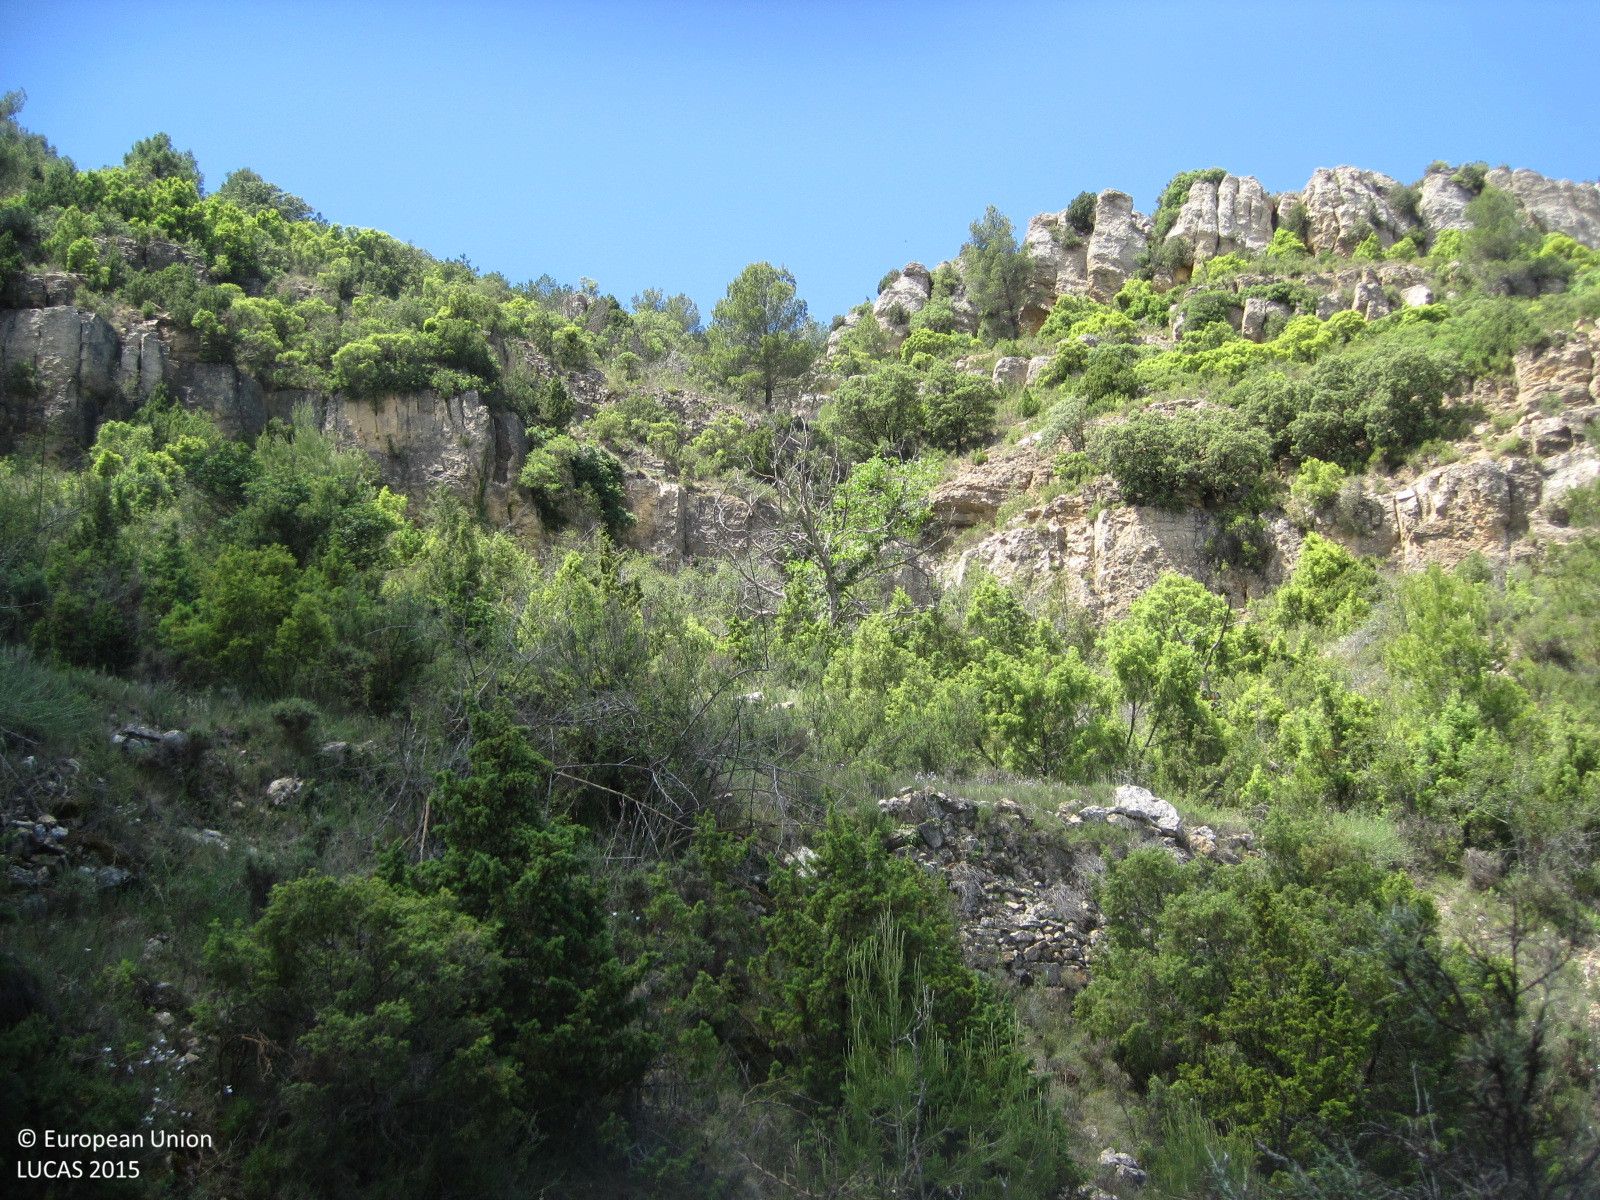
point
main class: Woodland
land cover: Broadleaved woodland
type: acidophilous oak and oak-birch forest
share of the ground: 10 - 25 %
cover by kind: broadleaved forest trees 30 %, shrubs 30 %, consolidated bare surface 25 %, herbaceous plants 10 %, coniferous forest trees 5 %
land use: Forestry
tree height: < 5 m
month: June
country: ES
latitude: 39.8678
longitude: -0.9824
